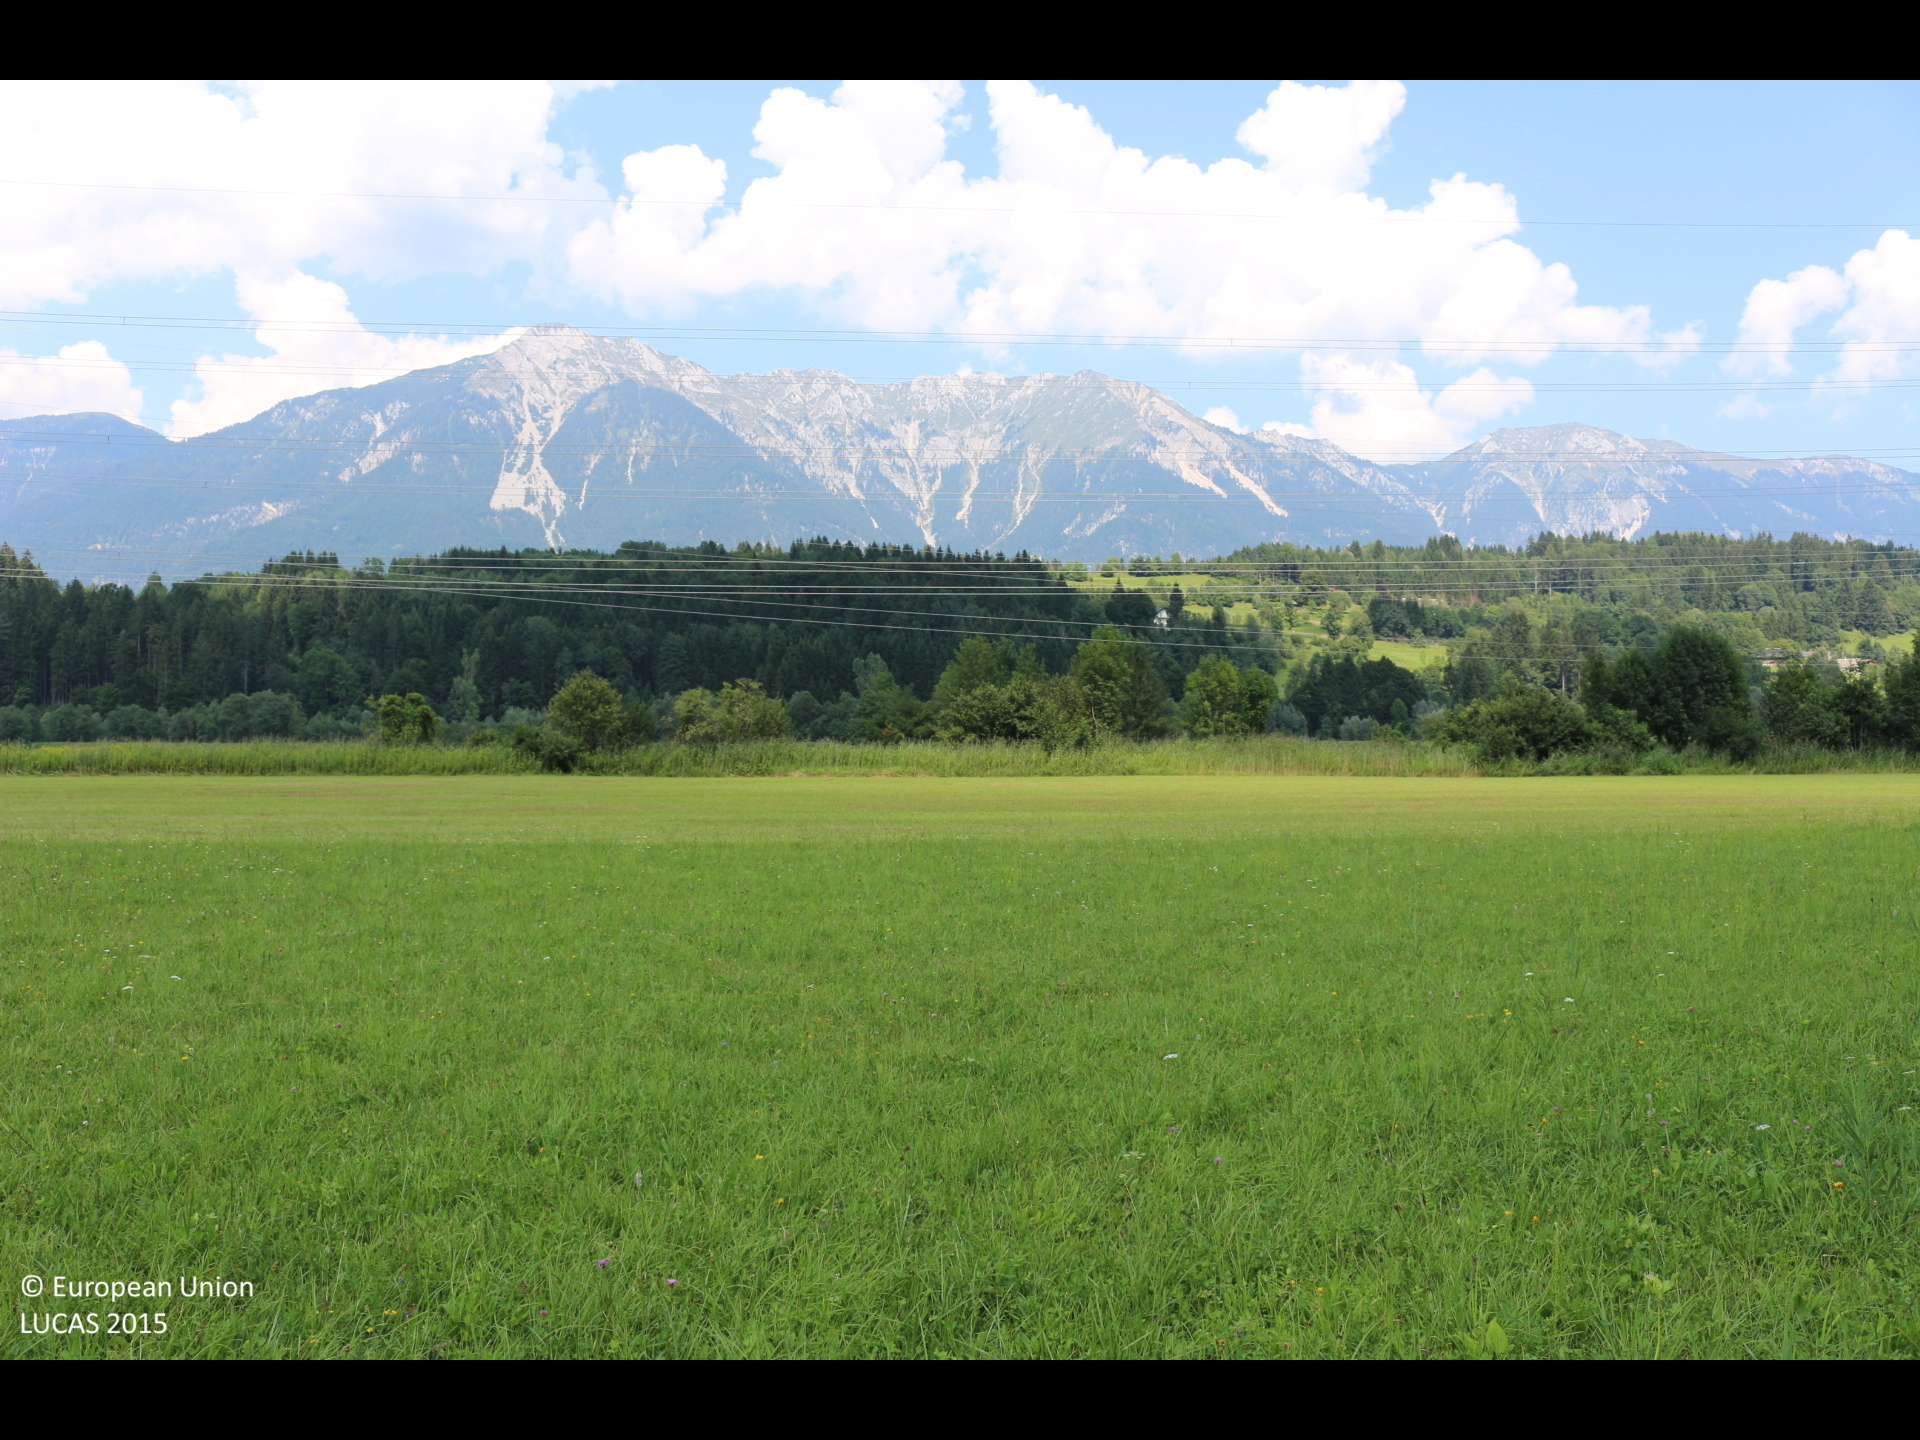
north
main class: Grassland
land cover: Grassland without tree/shrub cover
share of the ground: > 75 %
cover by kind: herbaceous plants 100 %
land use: Agriculture (excluding fallow land and kitchen gardens)
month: August
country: AT
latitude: 46.6035
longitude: 13.4045
